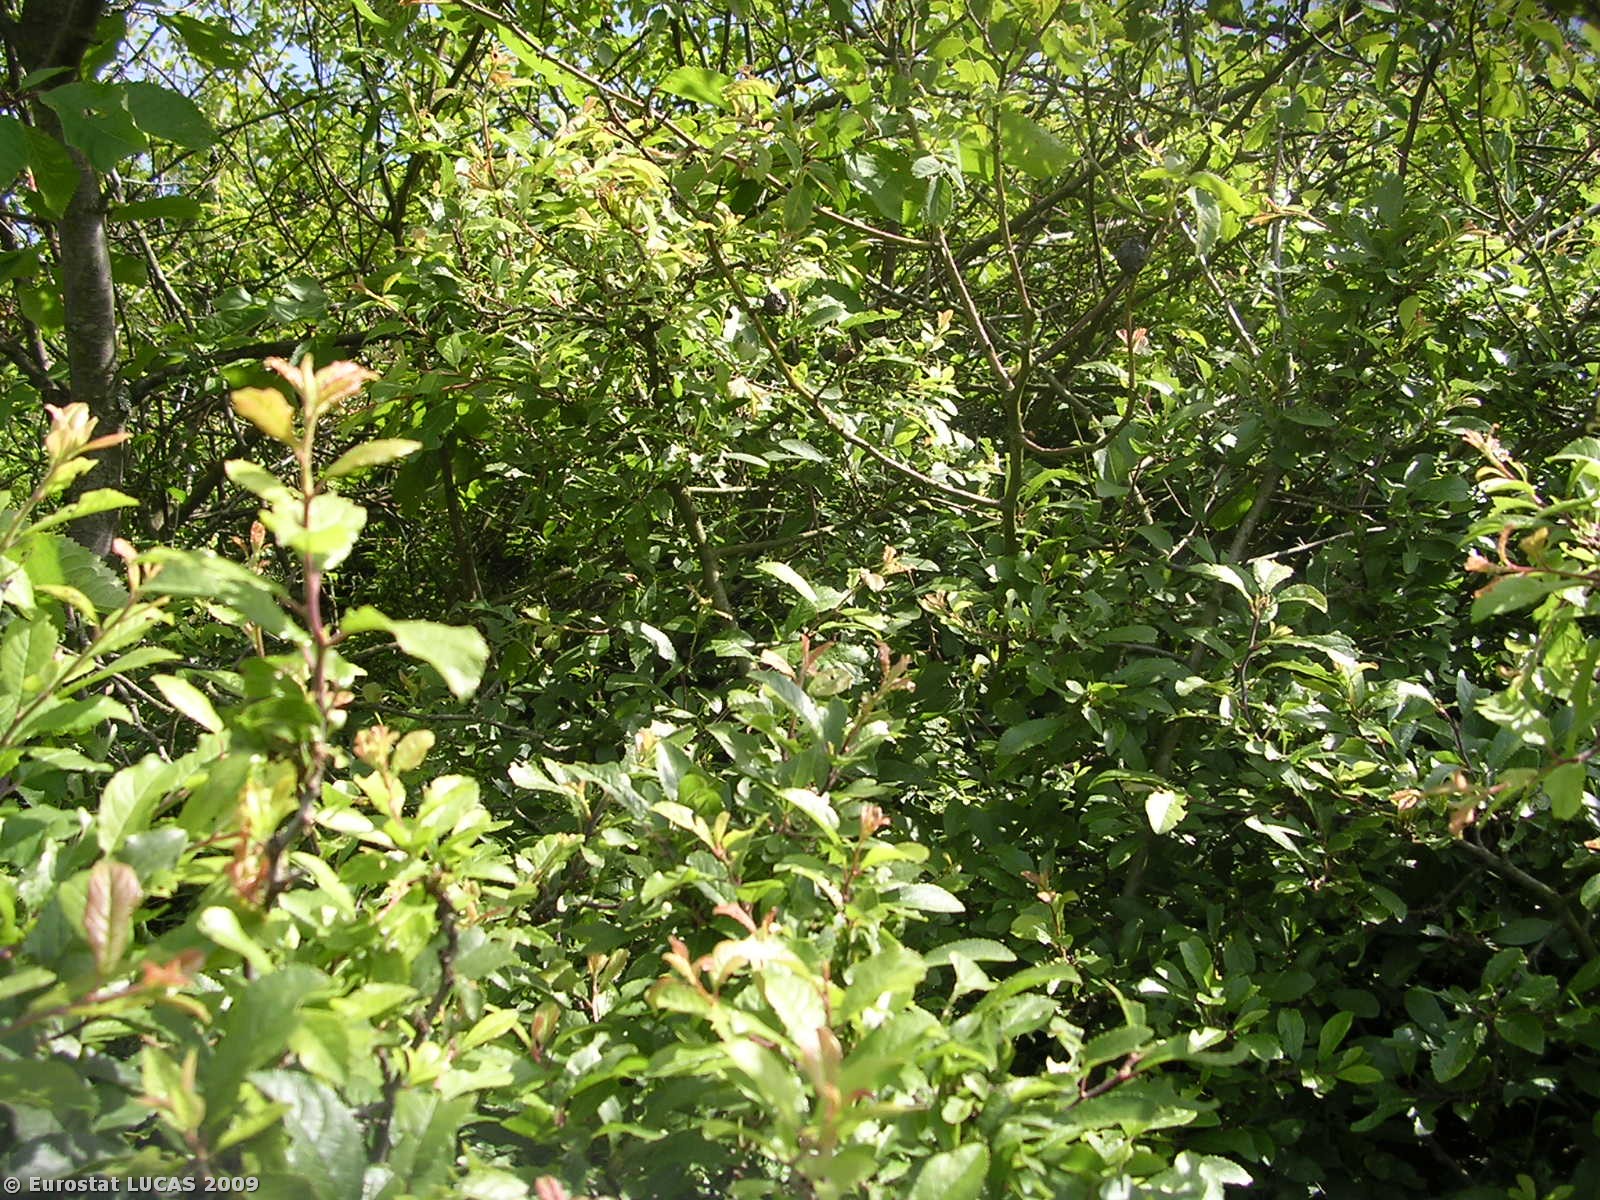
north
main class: Shrubland
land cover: Shrubland with sparse tree cover
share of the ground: 50 - 75 %
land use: Unused
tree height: > 5 m
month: June
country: CZ
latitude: 50.6730
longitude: 13.9772
